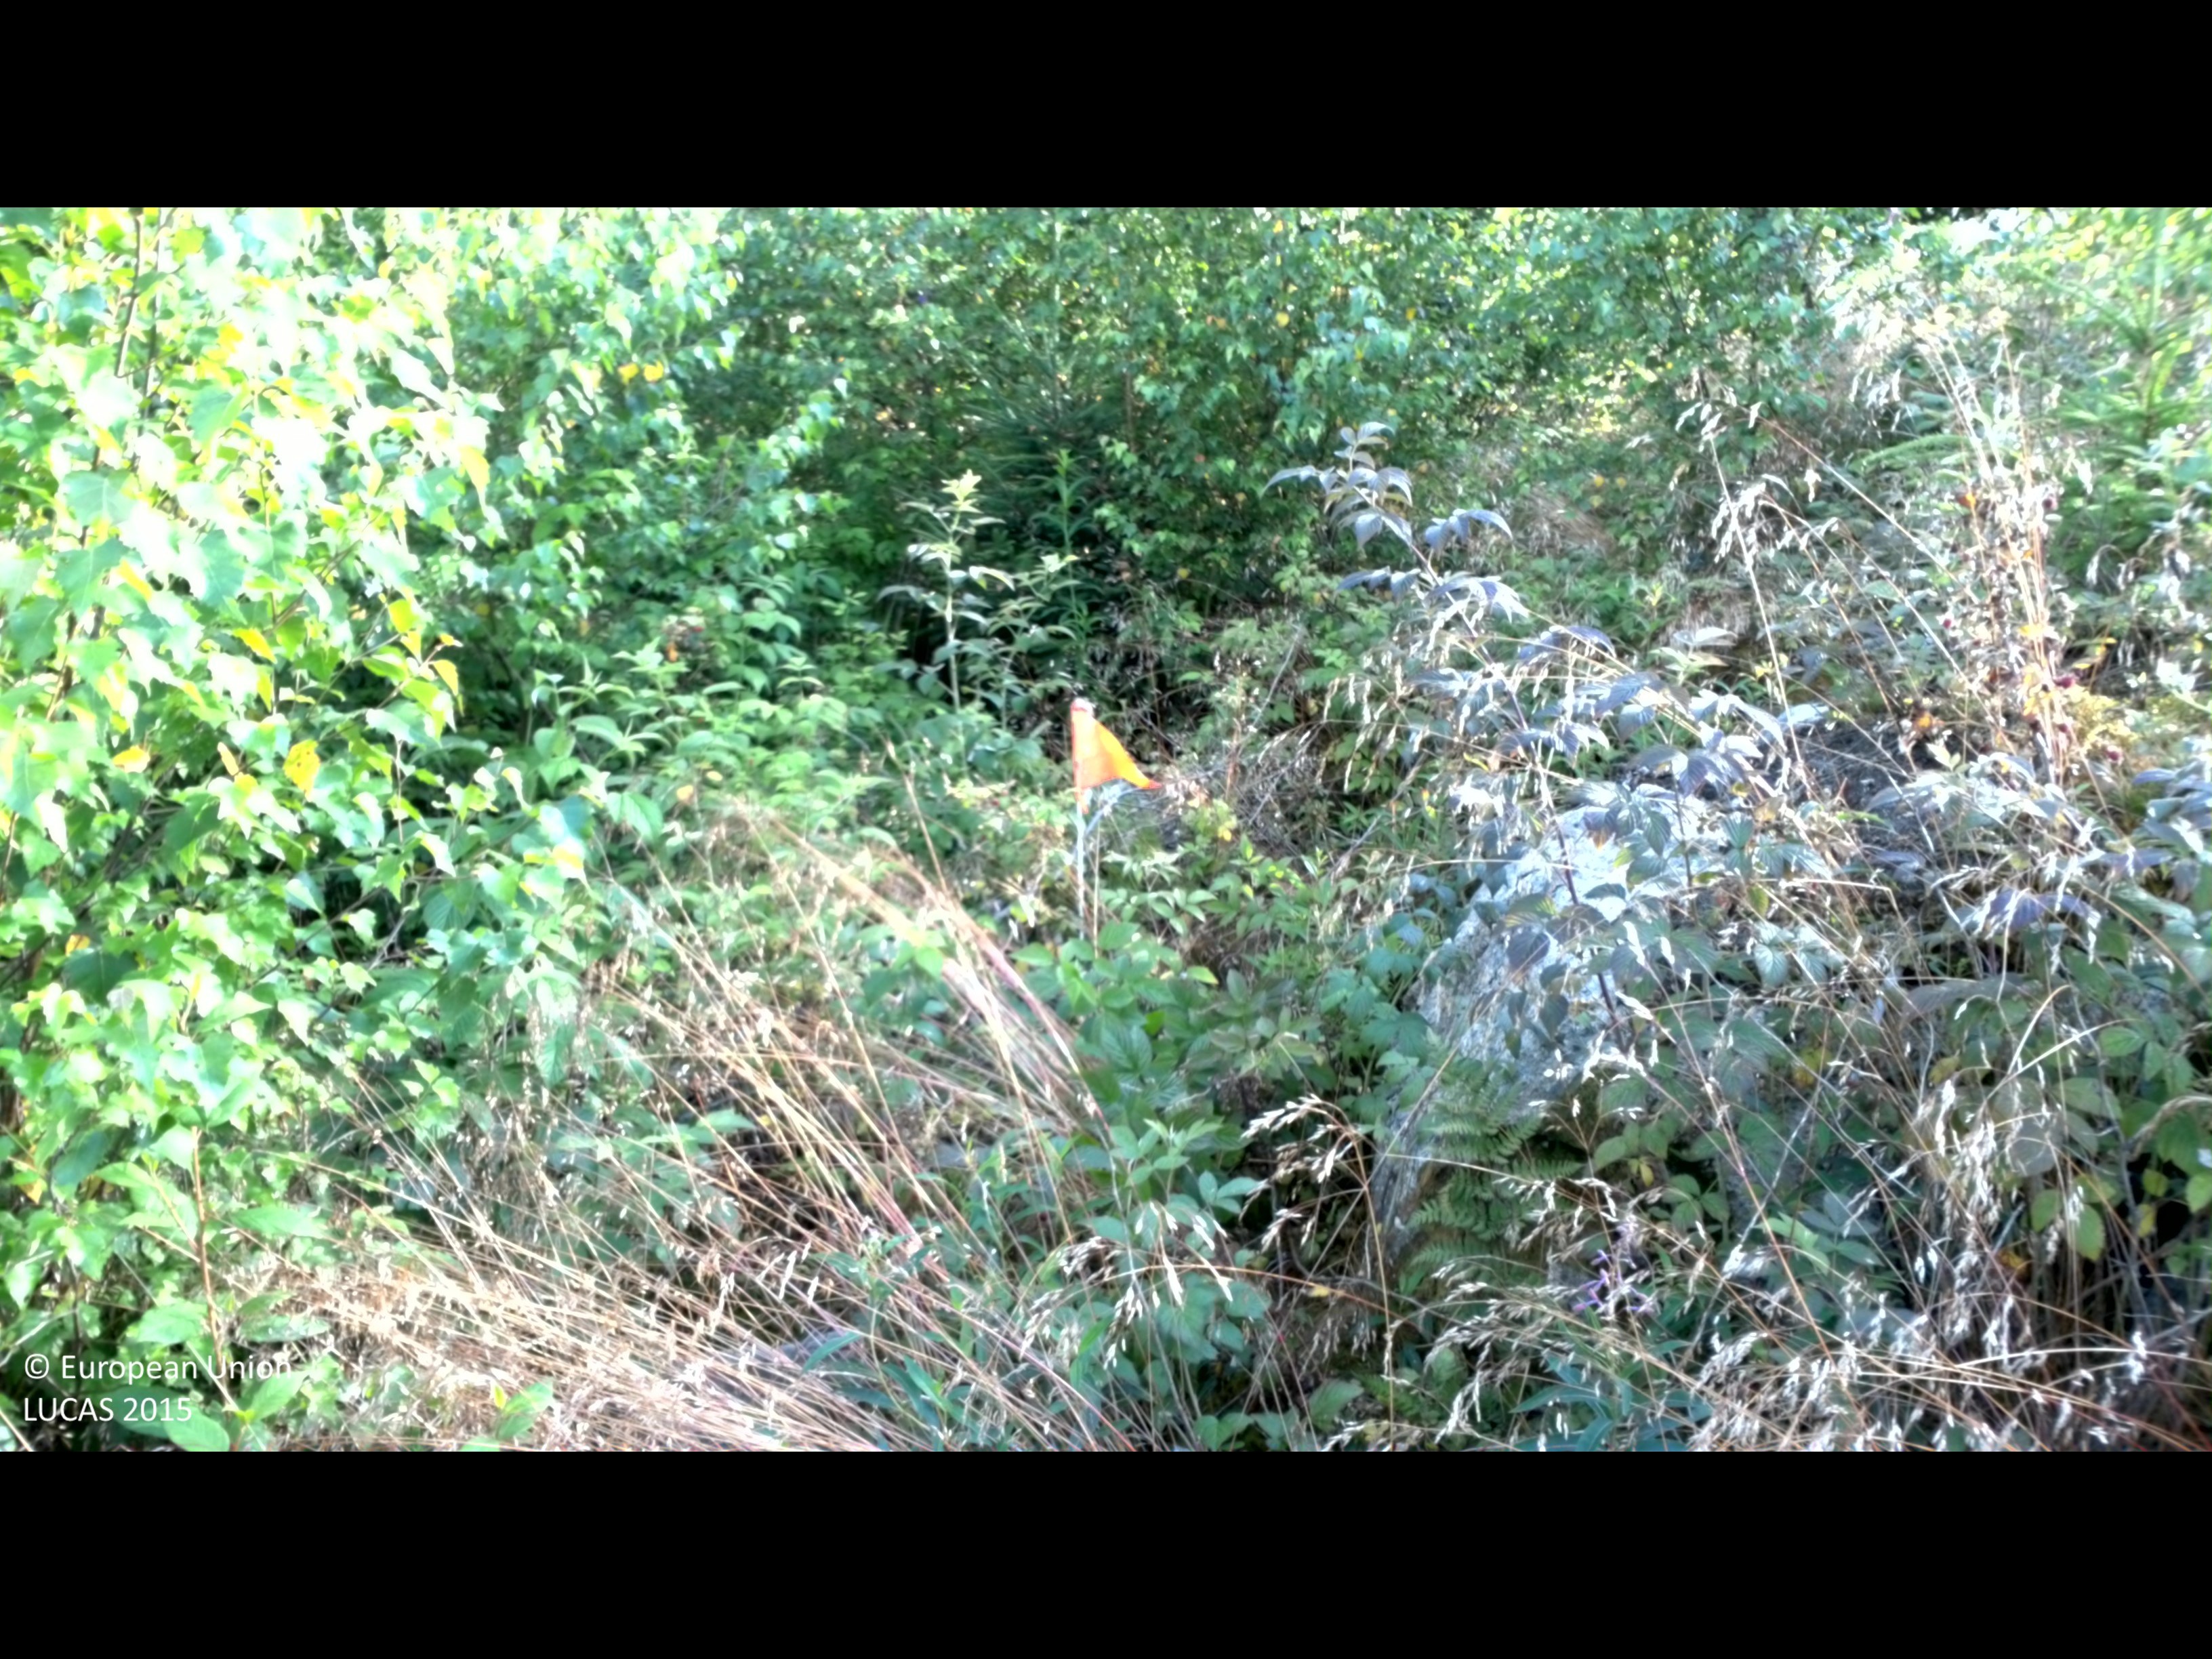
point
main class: Woodland
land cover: Broadleaved woodland
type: boreal forest
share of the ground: 50 - 75 %
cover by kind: broadleaved forest trees 65 %, herbaceous plants 20 %, shrubs 10 %, coniferous forest trees 5 %
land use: Forestry
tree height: < 5 m
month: August
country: SE
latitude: 56.3807
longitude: 14.4511
